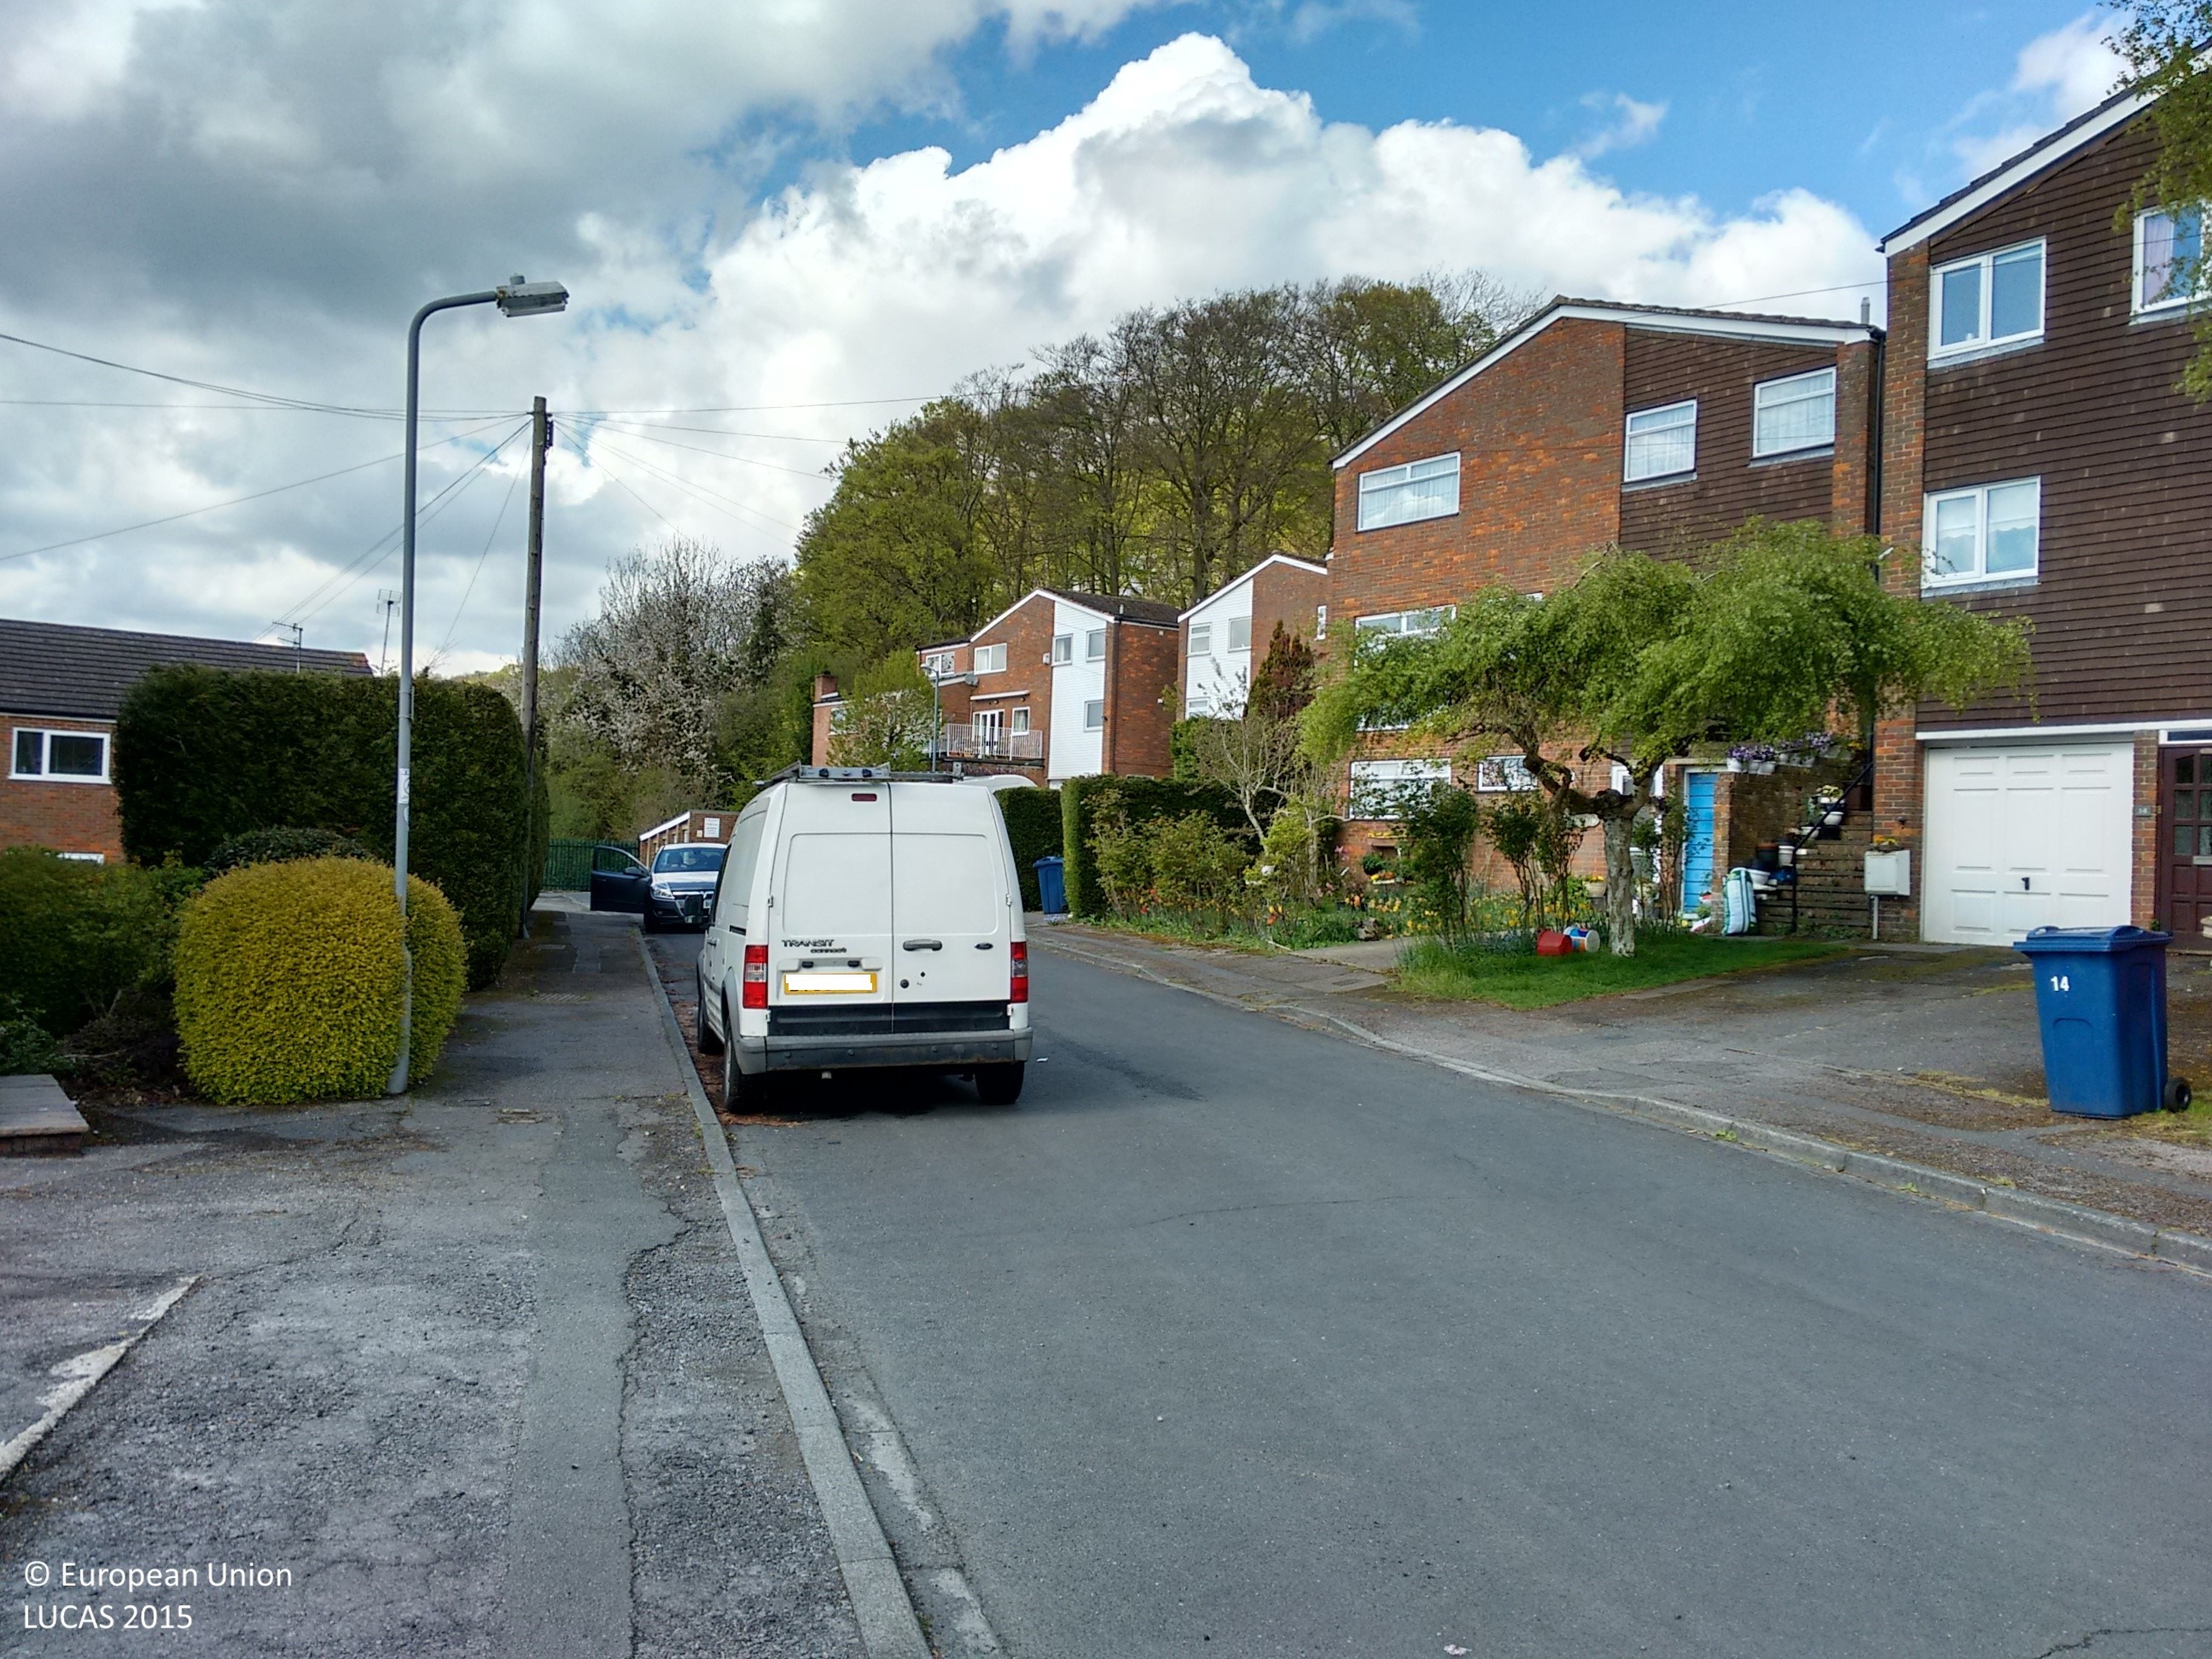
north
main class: Woodland
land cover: Broadleaved woodland
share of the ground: > 75 %
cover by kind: broadleaved forest trees 50 %, herbaceous plants 50 %
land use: Residential
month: April
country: GB
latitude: 51.7182
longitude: -0.6209
